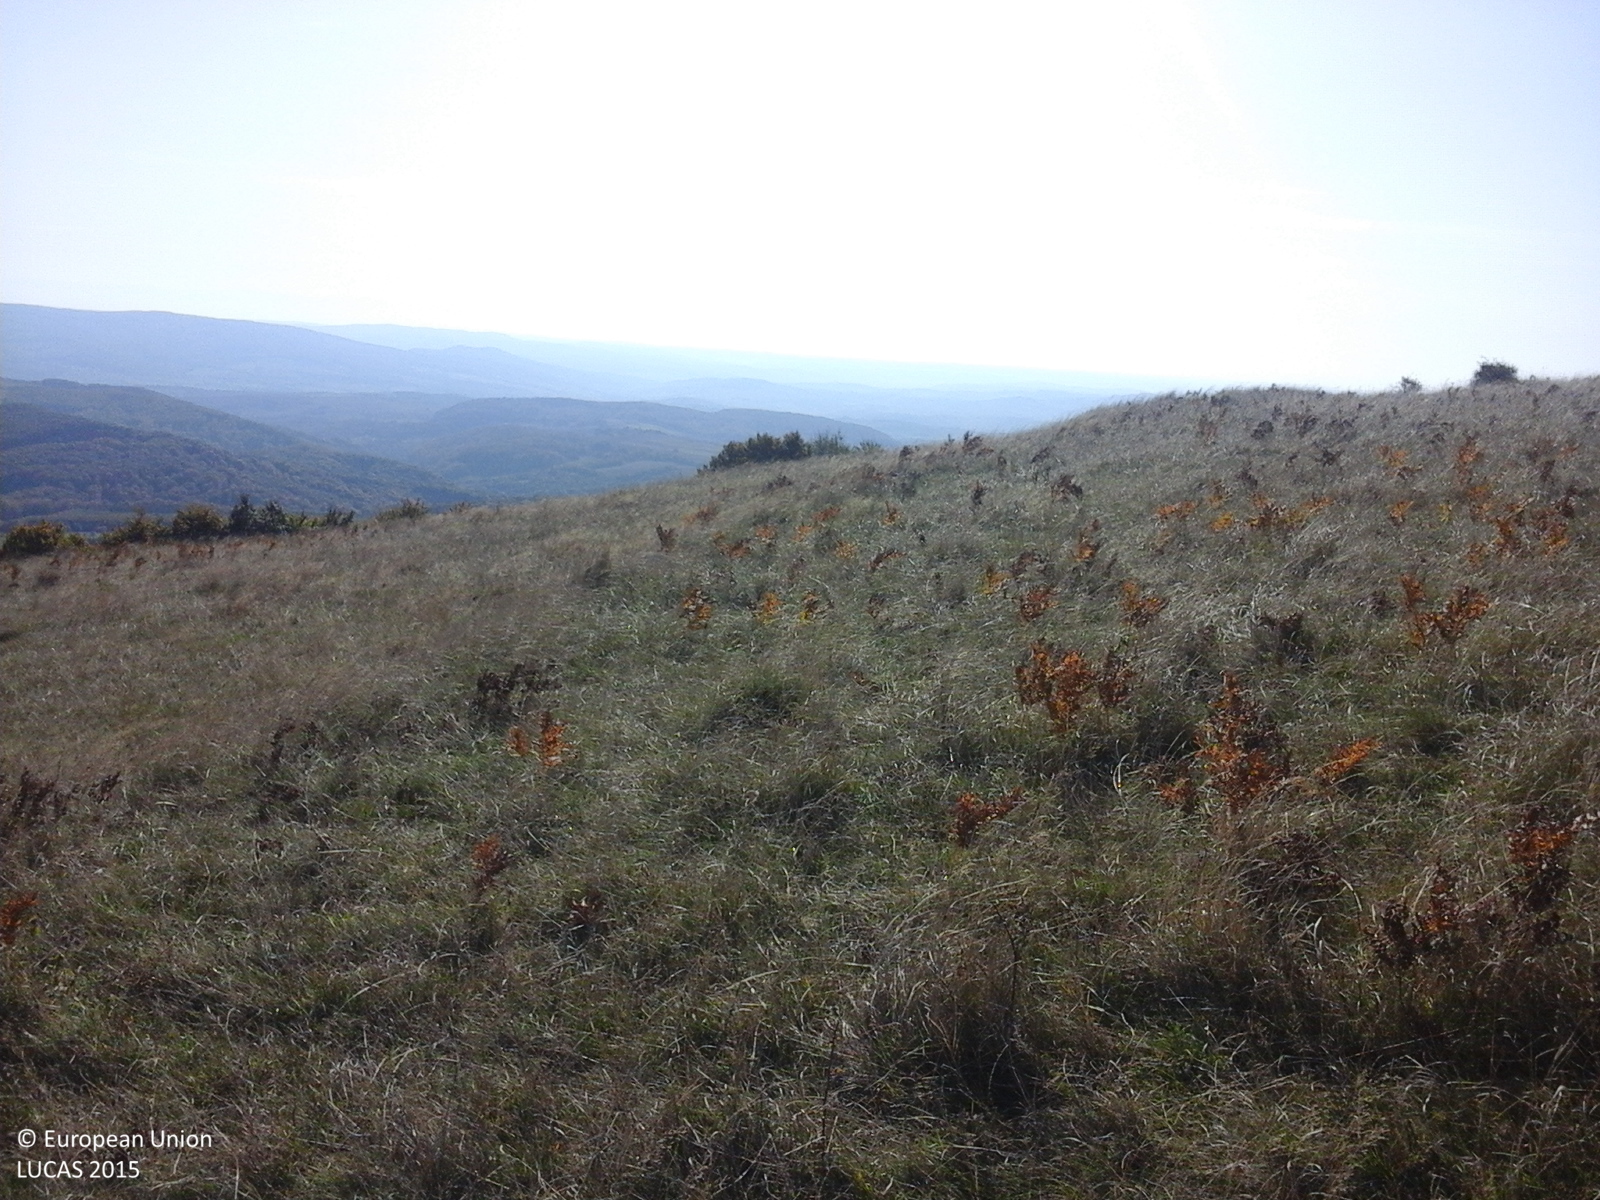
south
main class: Grassland
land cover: Grassland without tree/shrub cover
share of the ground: > 75 %
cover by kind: herbaceous plants 100 %
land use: Agriculture (excluding fallow land and kitchen gardens)
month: October
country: RO
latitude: 46.4314
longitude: 25.1841
